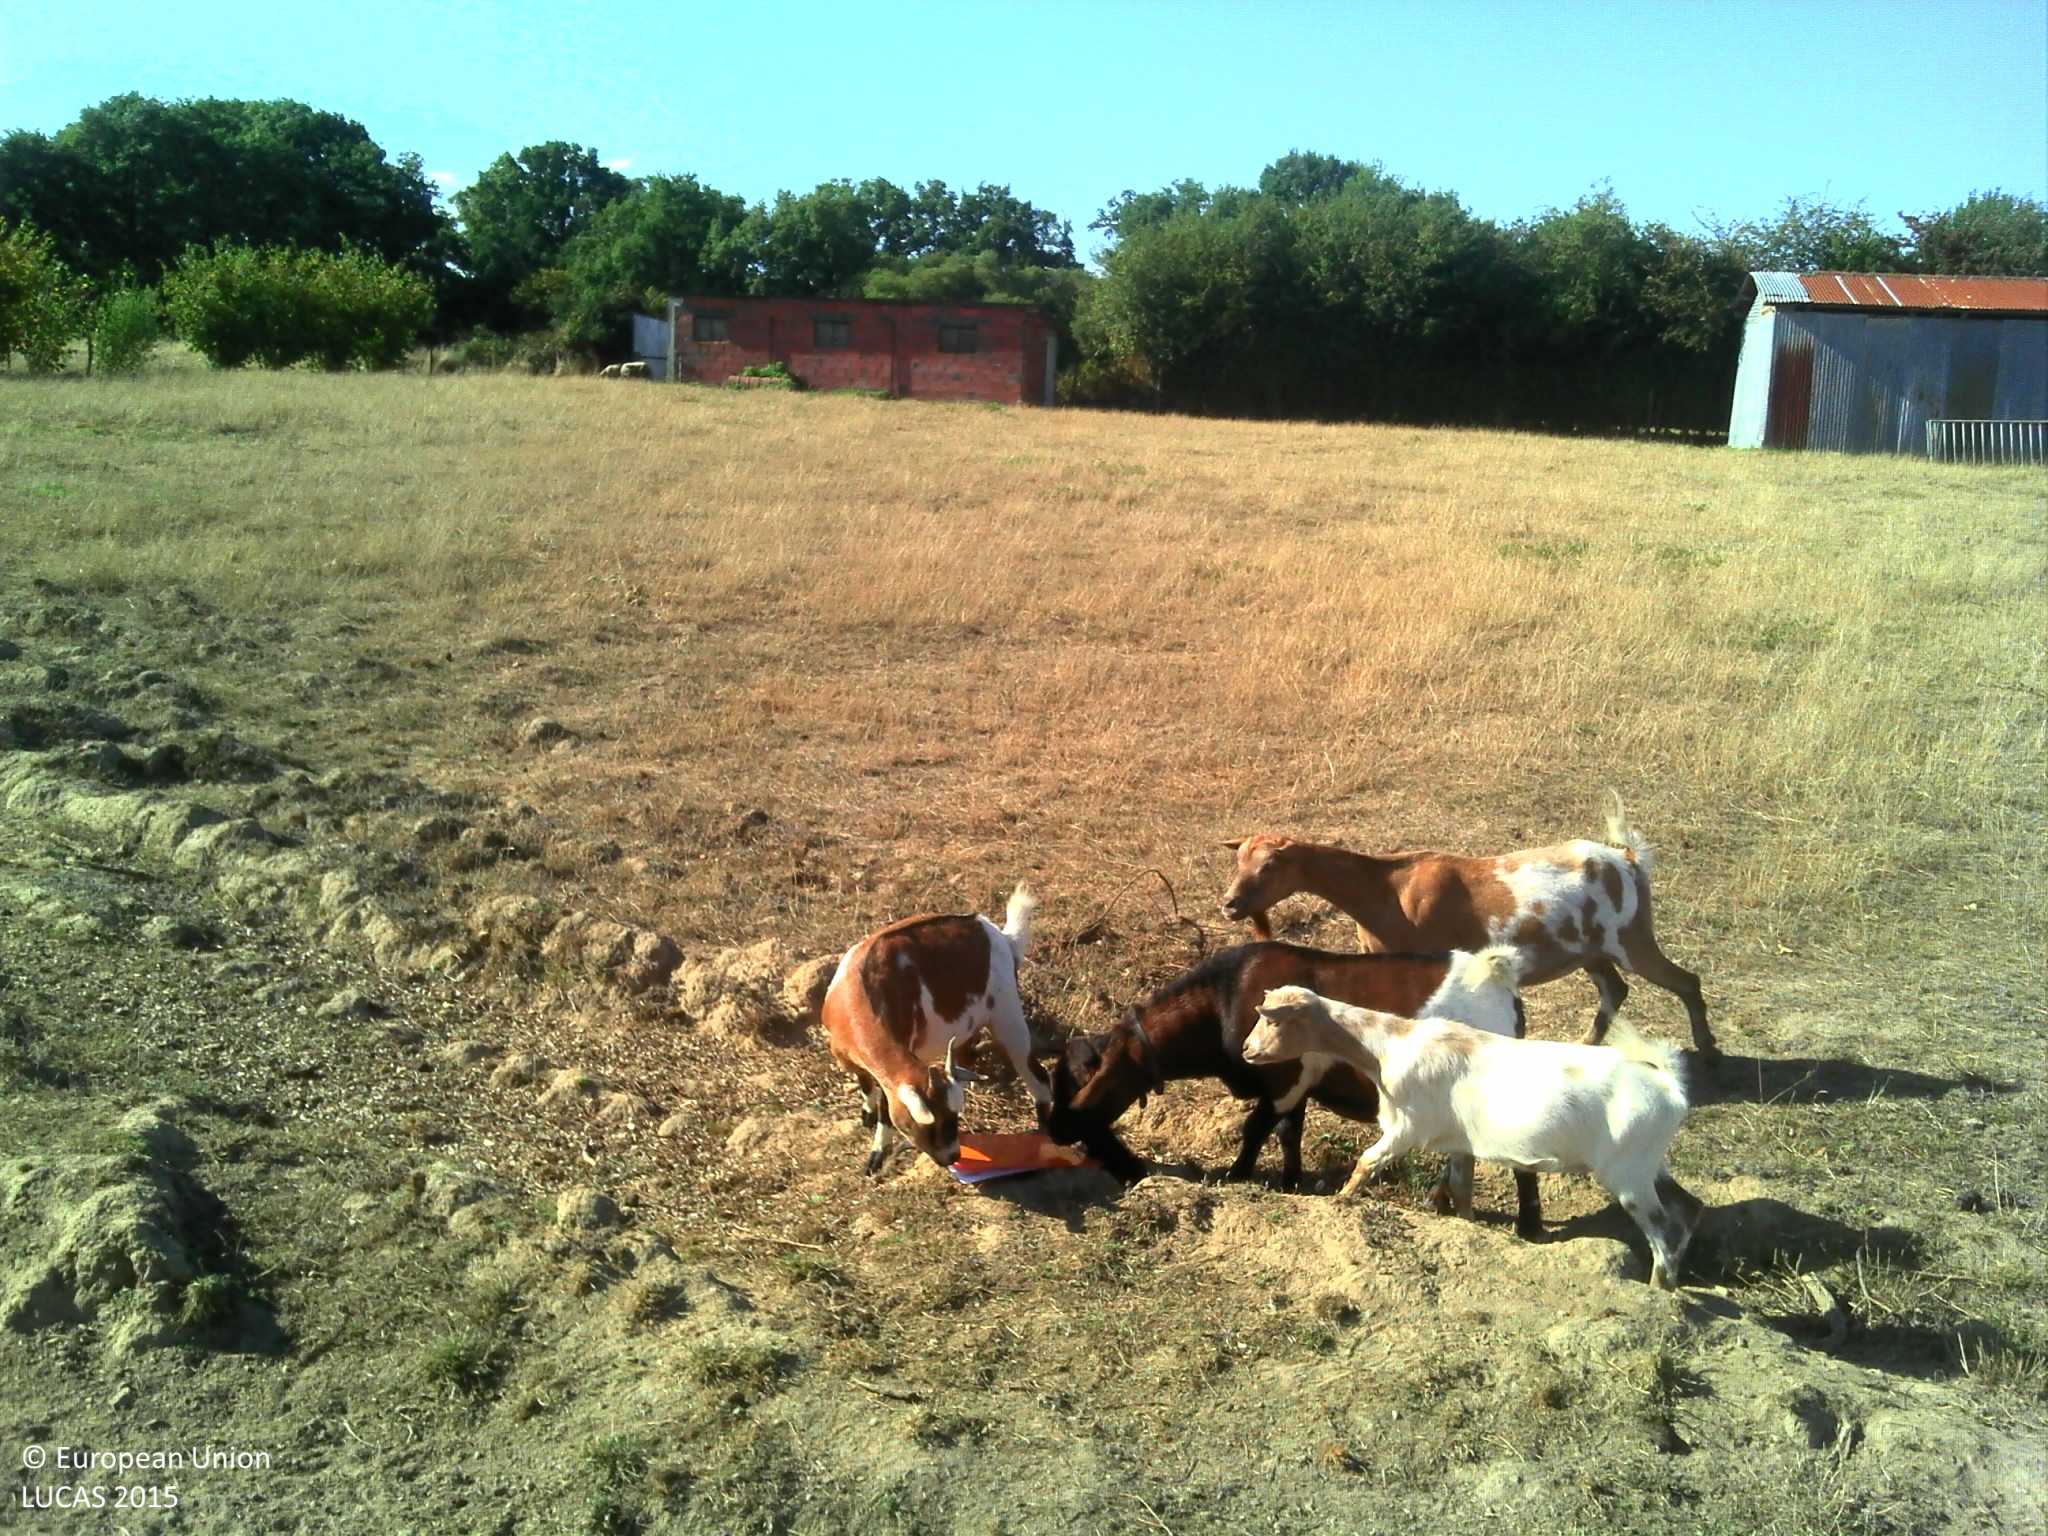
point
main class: Grassland
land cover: Grassland without tree/shrub cover
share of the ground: > 75 %
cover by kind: herbaceous plants 95 %, shrubs 5 %
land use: Residential
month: August
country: FR
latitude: 46.6767
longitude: -1.1329
